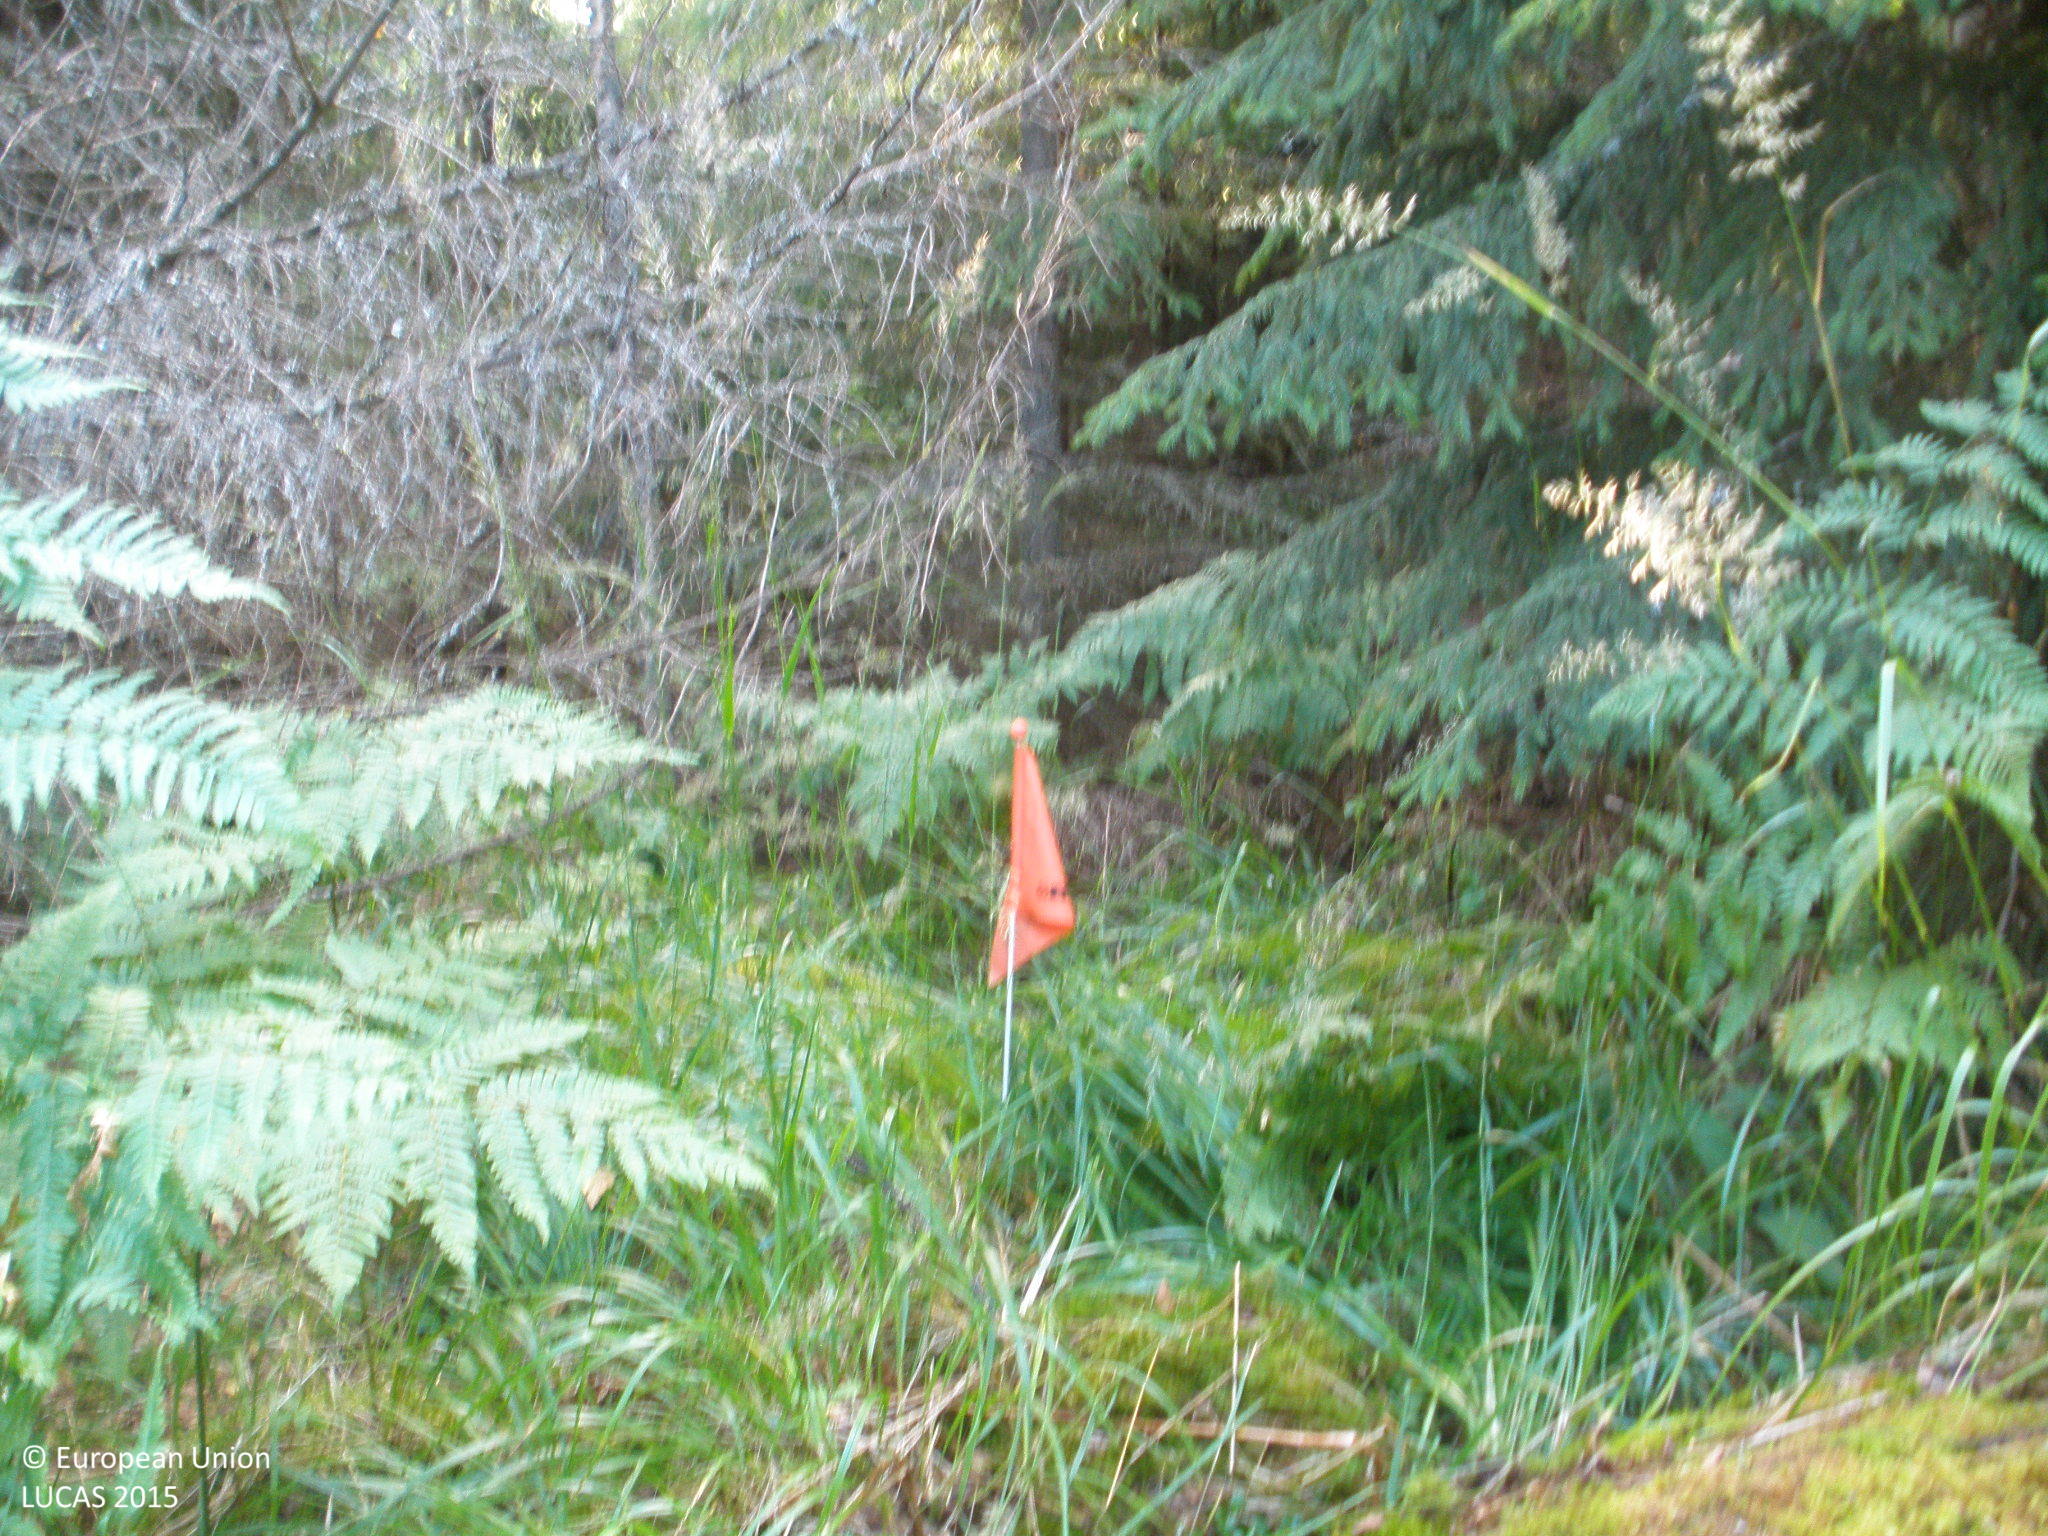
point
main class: Woodland
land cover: Spruce dominated mixed woodland
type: boreal forest
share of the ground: > 75 %
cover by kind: coniferous forest trees 60 %, broadleaved forest trees 25 %, herbaceous plants 10 %, lichens and mosses 5 %
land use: Forestry
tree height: > 5 m
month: August
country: FI
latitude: 60.7050
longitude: 24.3744
